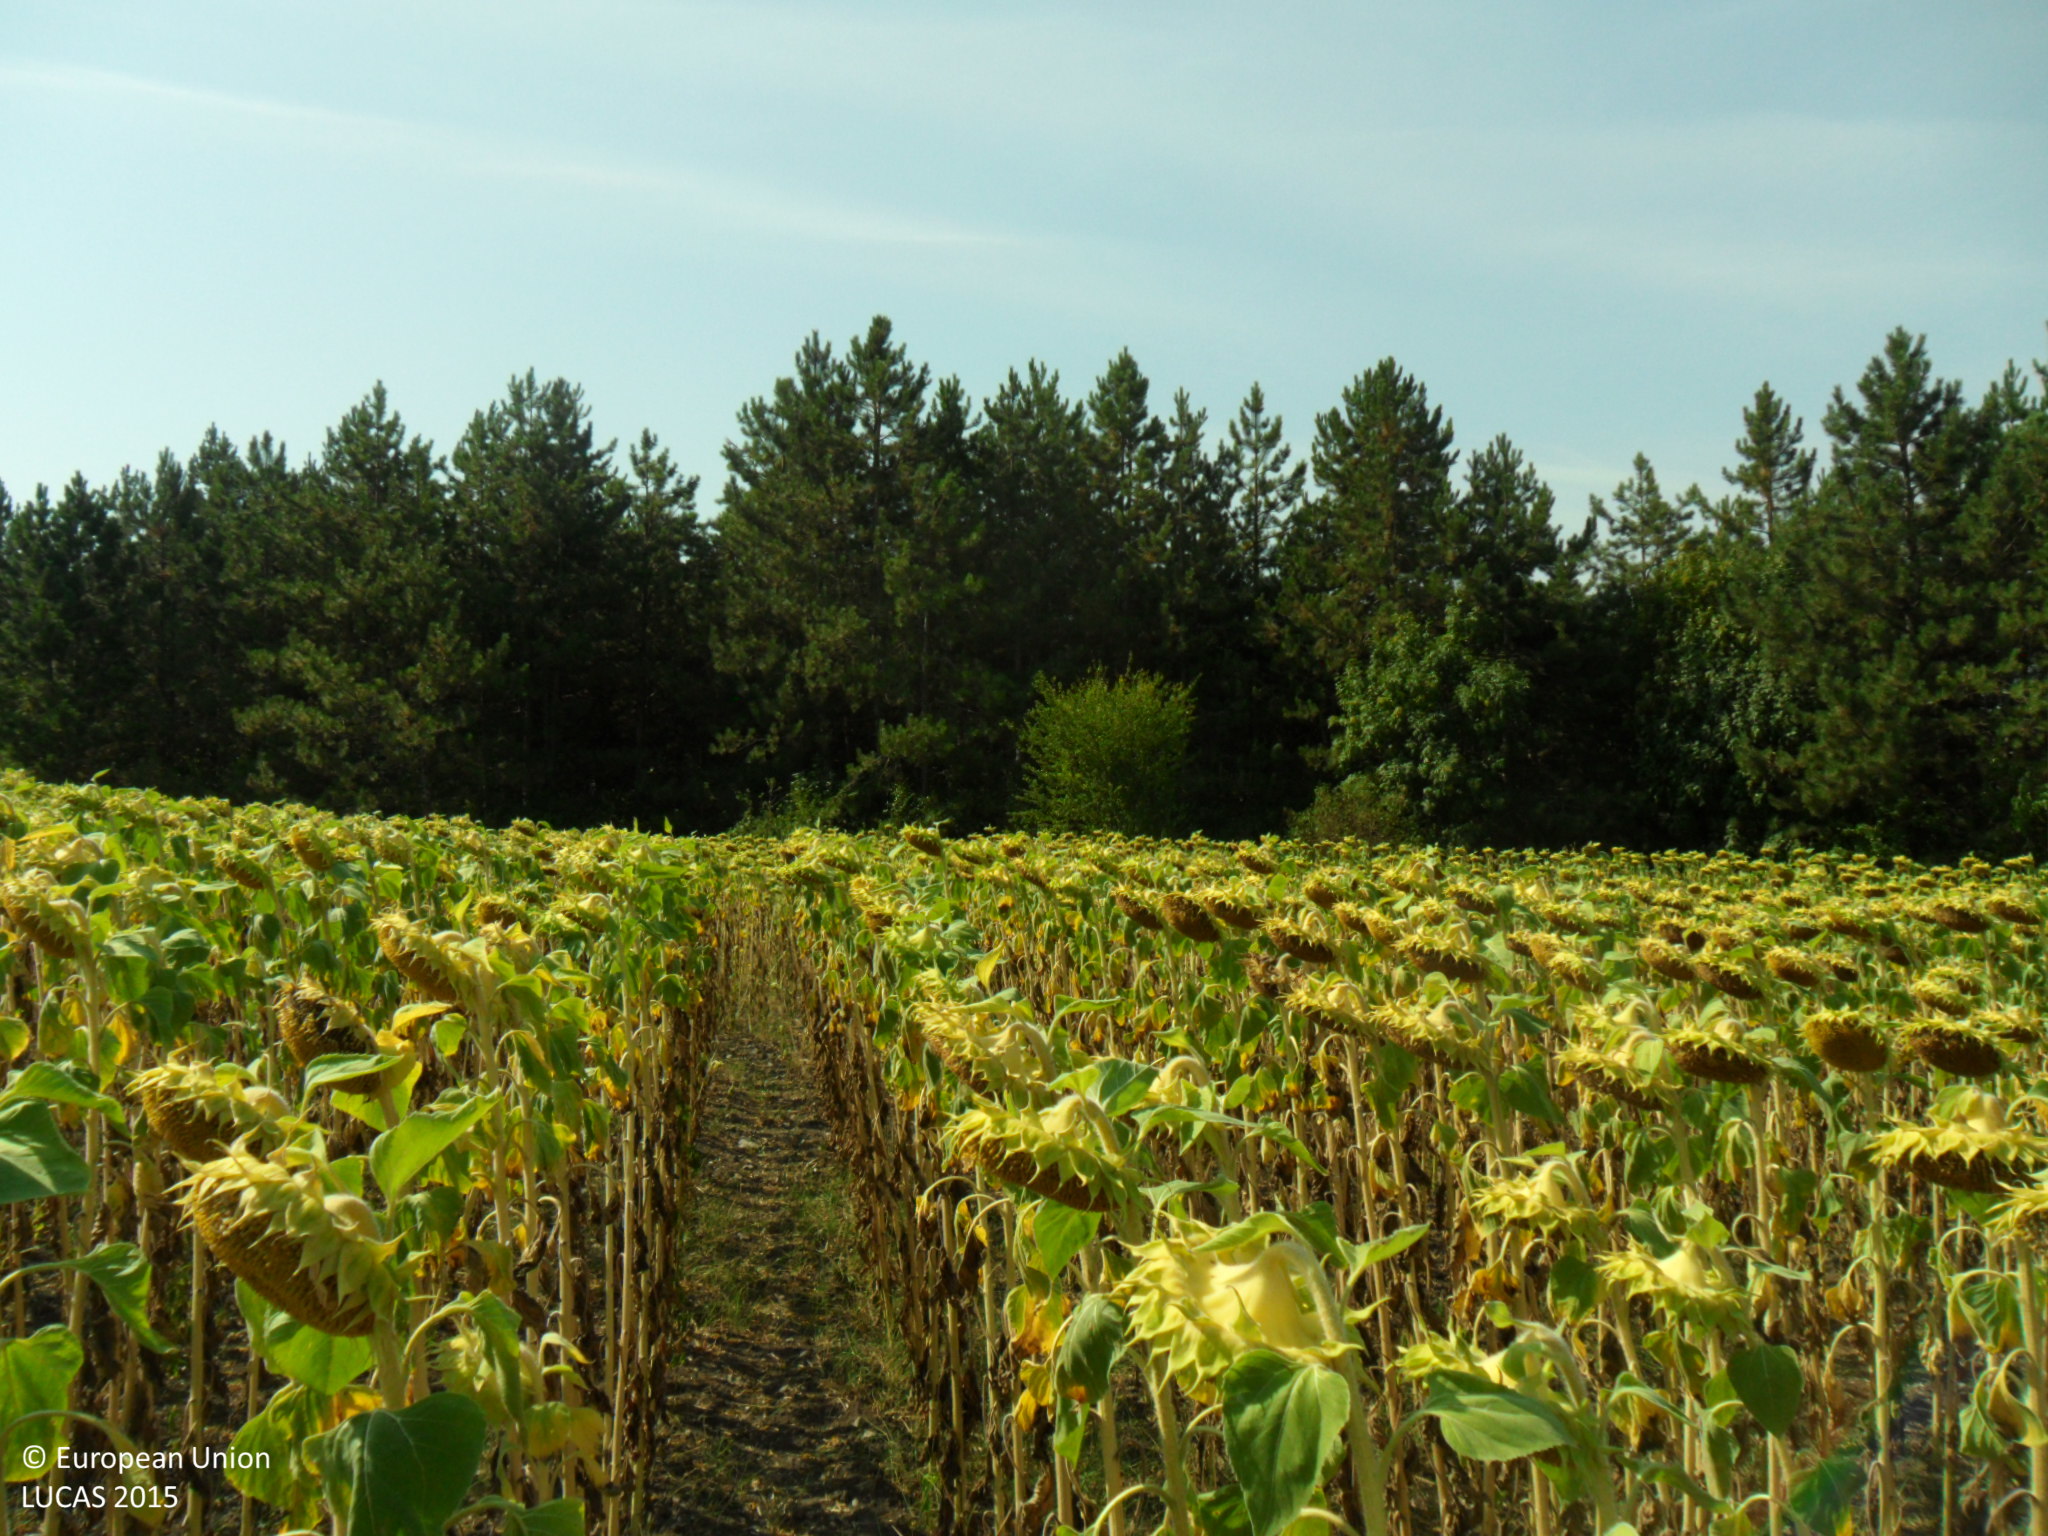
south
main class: Cropland
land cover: Sunflower
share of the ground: > 75 %
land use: Agriculture (excluding fallow land and kitchen gardens)
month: August
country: BG
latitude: 43.3856
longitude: 26.8382
